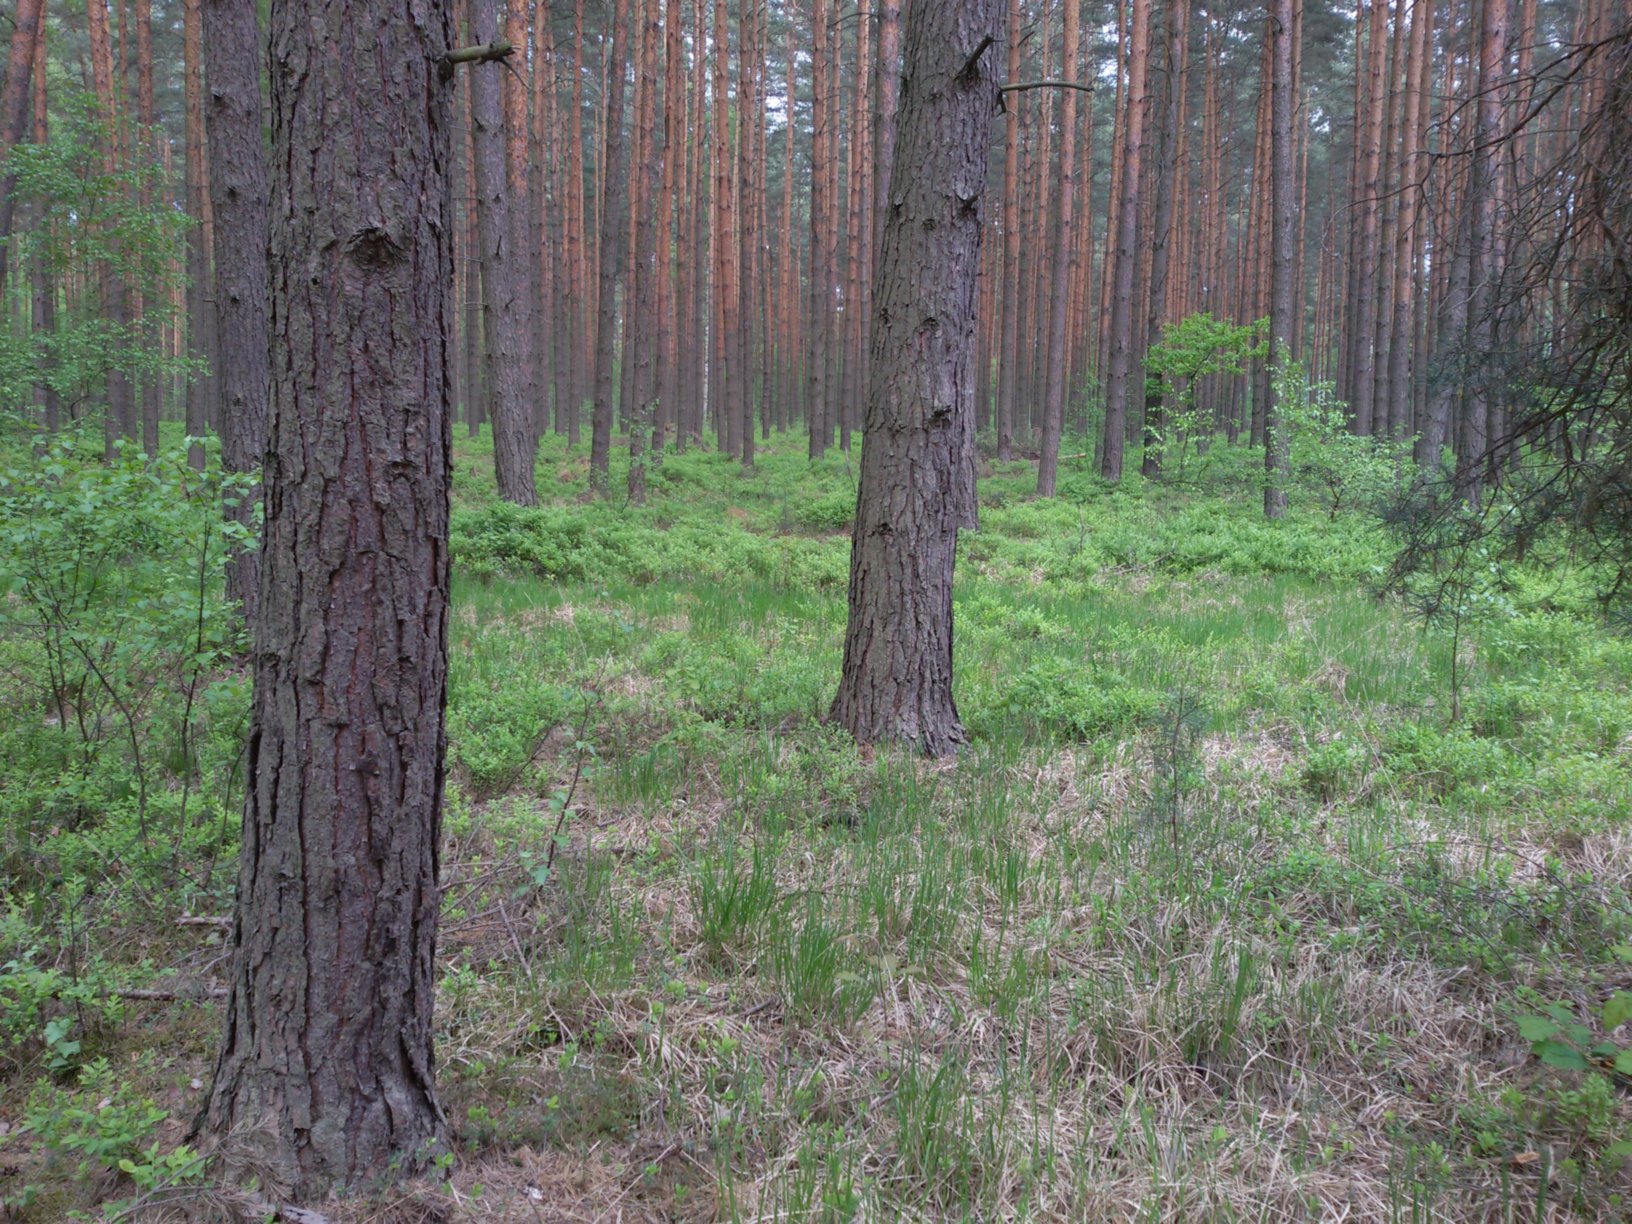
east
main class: Woodland
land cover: Pine dominated coniferous woodland
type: hemiboreal forest and nemoral coniferous forest and mixed broadleaved-coniferous forest
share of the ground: > 75 %
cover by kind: coniferous forest trees 75 %, herbaceous plants 10 %, lichens and mosses 10 %, broadleaved forest trees 5 %
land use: Forestry
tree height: > 5 m
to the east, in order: Pine dominated coniferous woodland
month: May
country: PL
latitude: 51.4096
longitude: 15.7414
